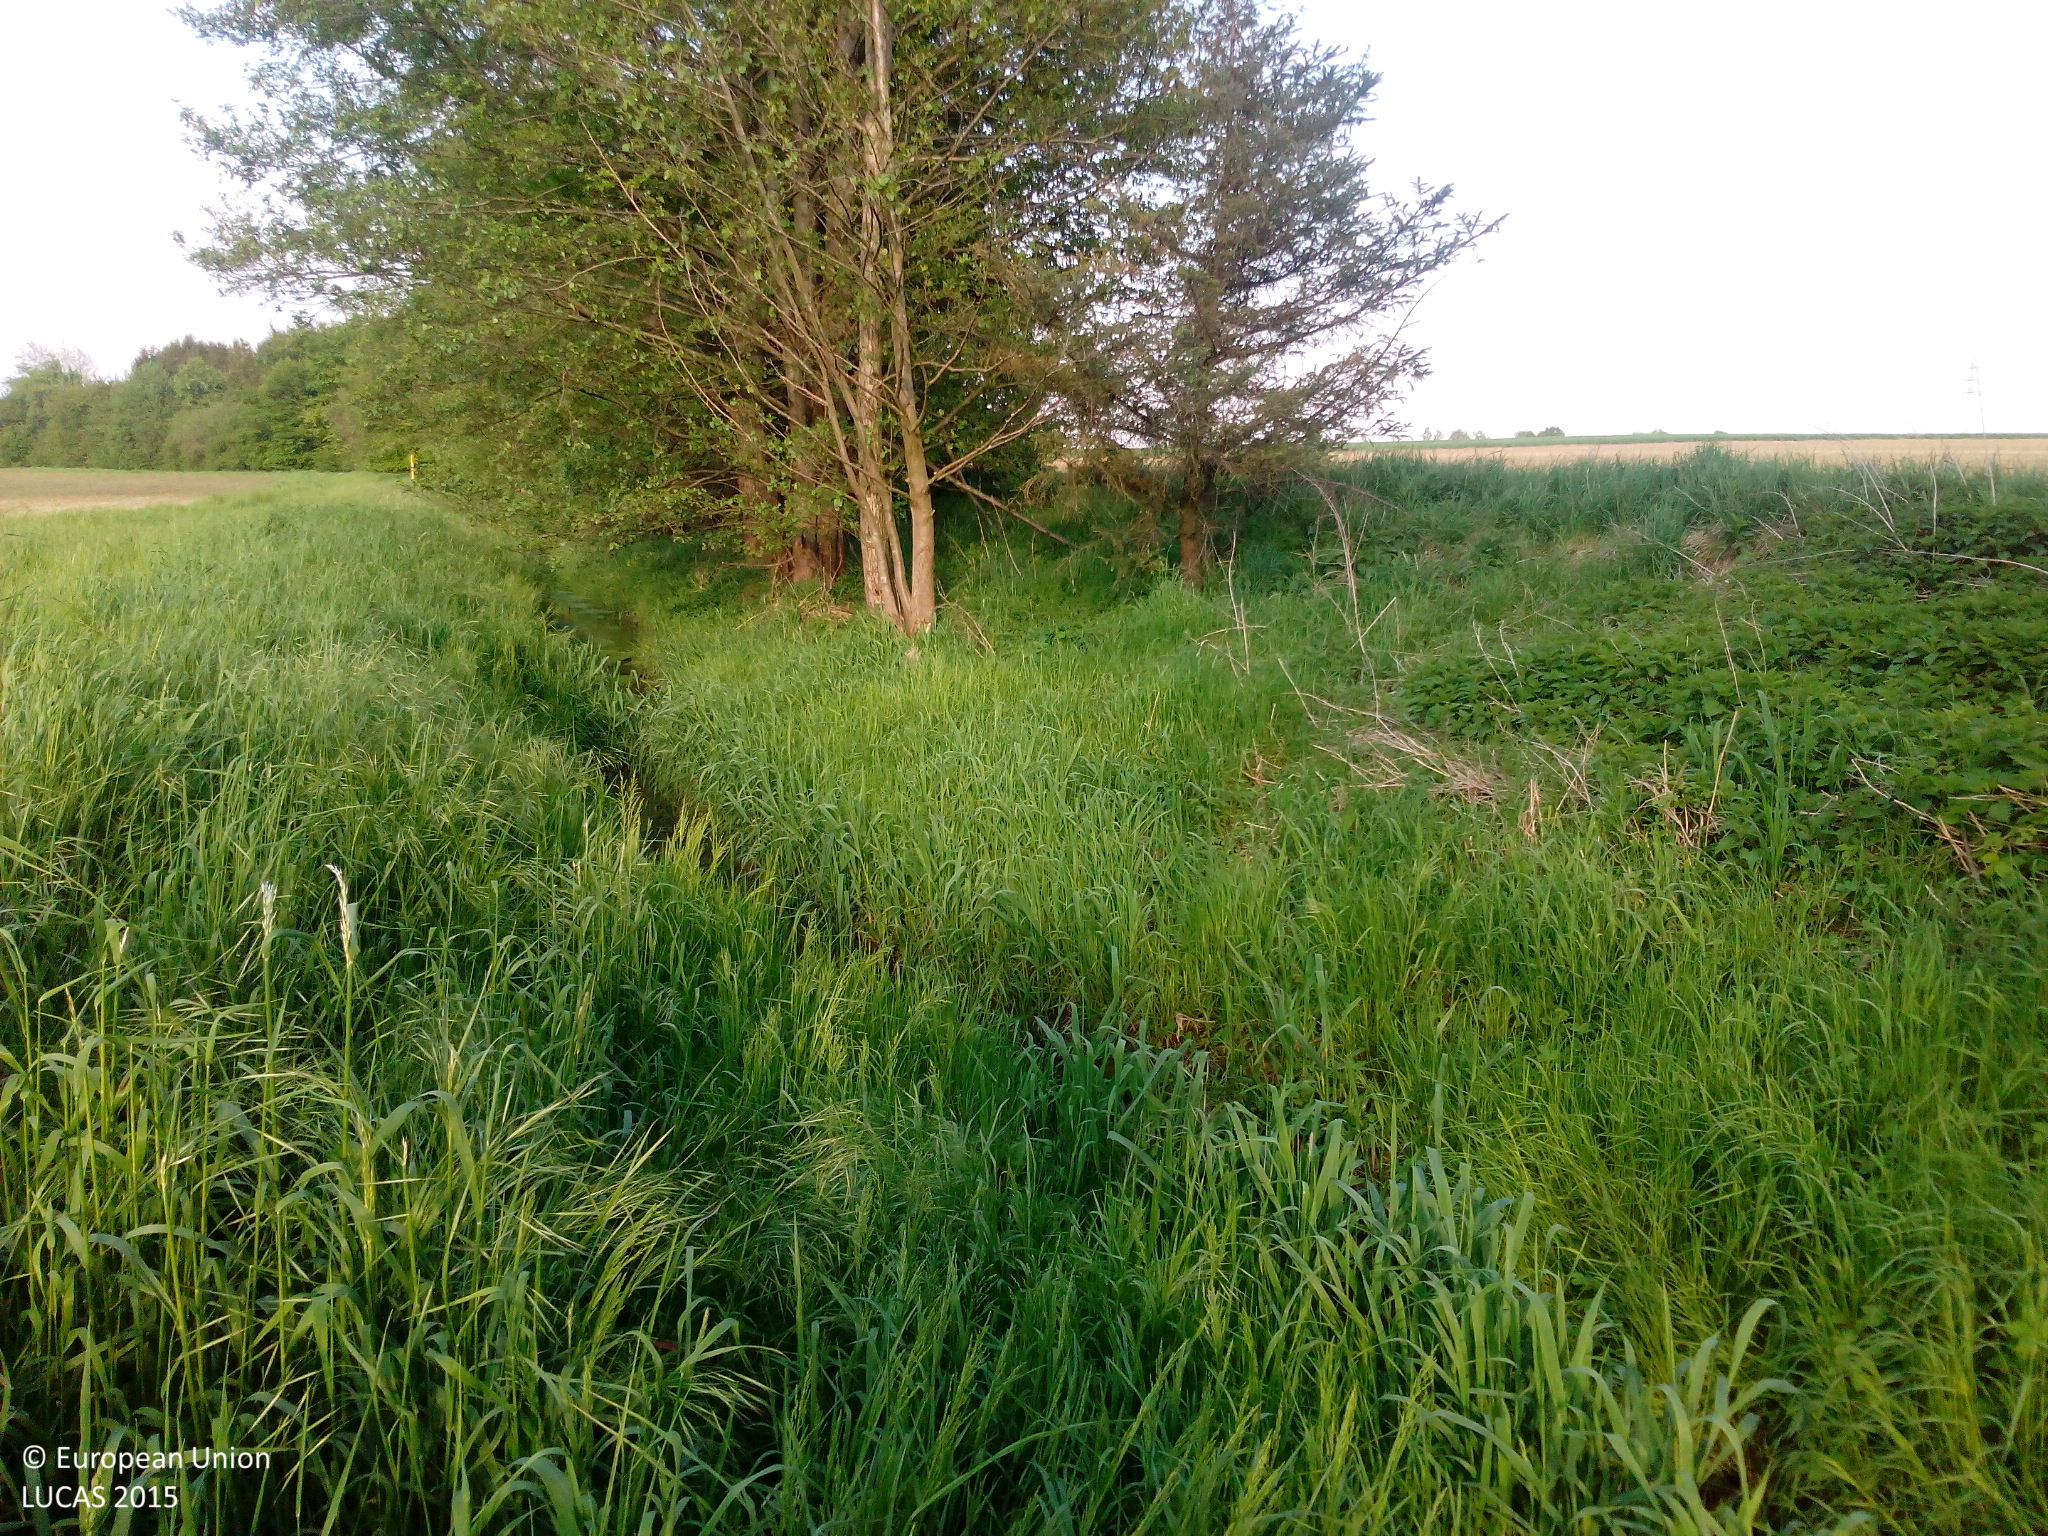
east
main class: Grassland
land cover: Grassland without tree/shrub cover
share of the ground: > 75 %
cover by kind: herbaceous plants 100 %
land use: Agriculture (excluding fallow land and kitchen gardens)
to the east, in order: Grassland without tree/shrub cover; Rivers and streams; Grass margins; Spruce dominated mixed woodland; Shruby margins; Tracks; Broadleaved woodland; Tracks; Grass margins; Common wheat
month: May
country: DE
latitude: 51.8389
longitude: 7.9830
